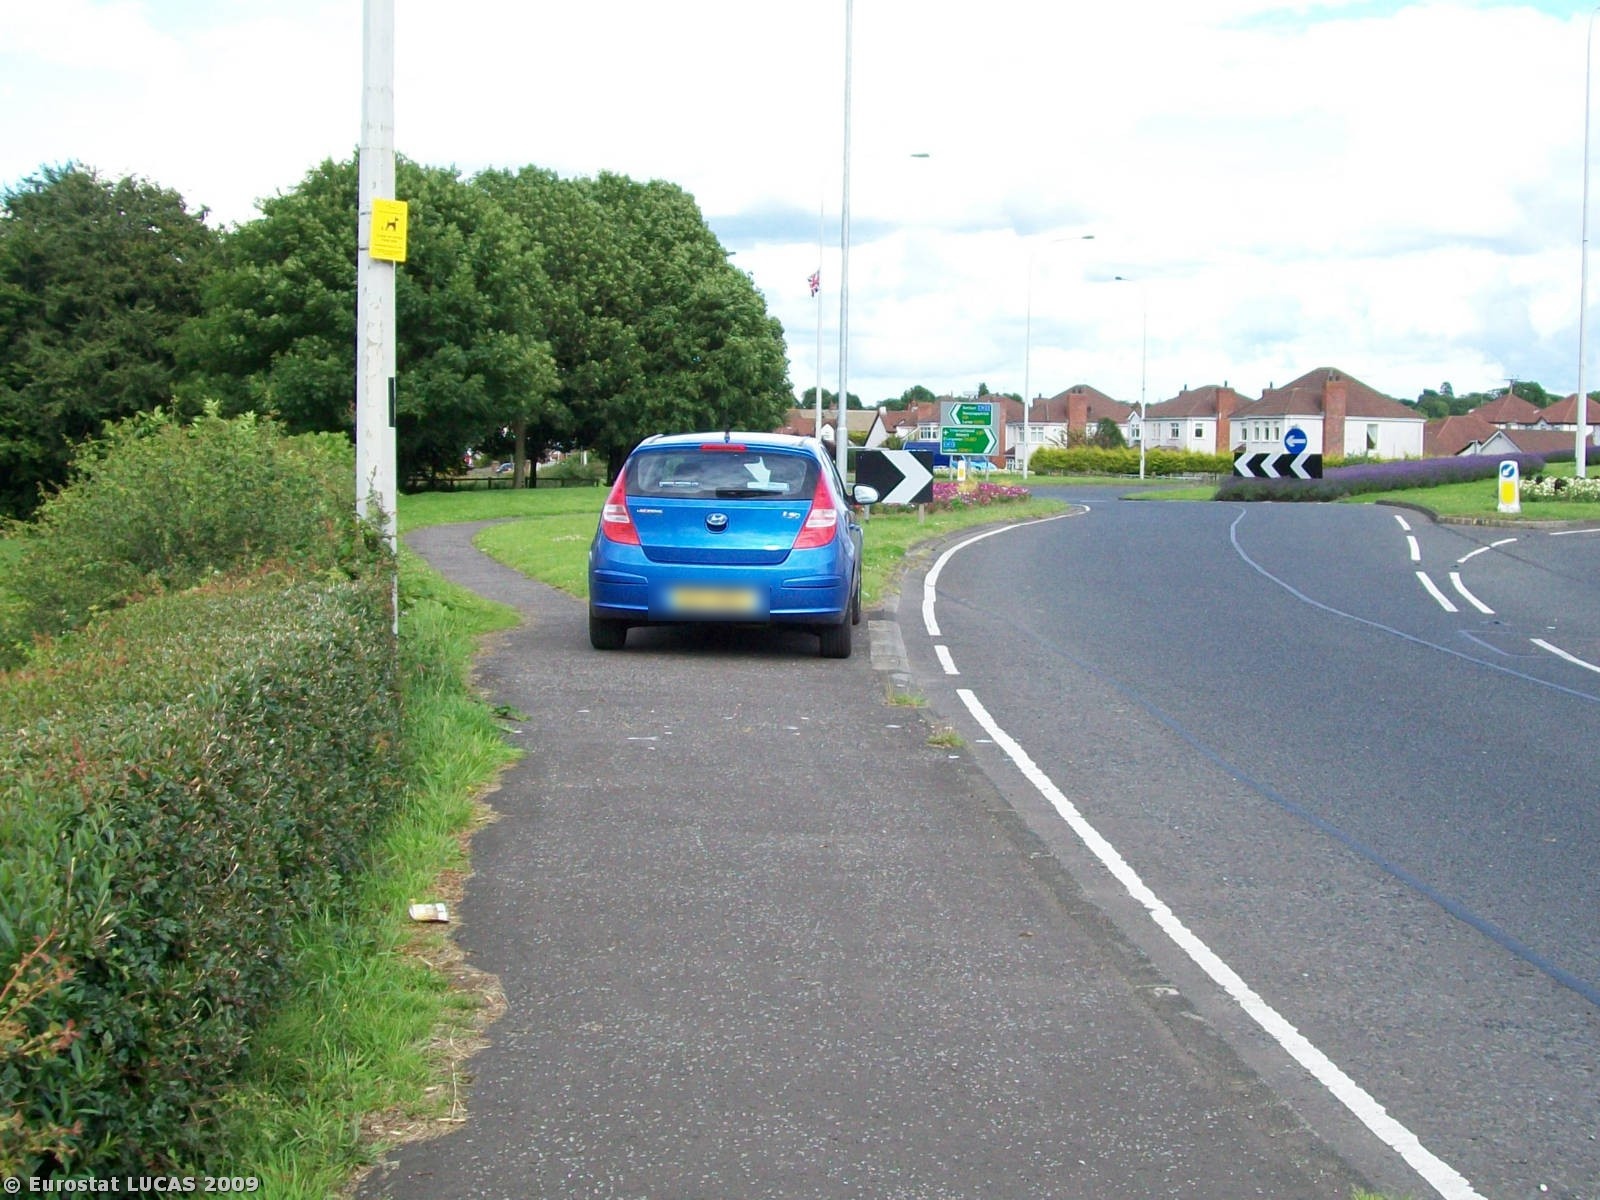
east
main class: Grassland
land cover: Grassland without tree/shrub cover
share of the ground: > 75 %
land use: Agriculture (excluding fallow land and kitchen gardens)
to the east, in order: Grassland without tree/shrub cover; Fences; Managed hedges; Grassland without tree/shrub cover; Fences; Abandoned hedges; Artificial constructions in urban areas; Paved roads, cycling and walking lanes; Artificial constructions in urban areas
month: July
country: GB
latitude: 54.7002
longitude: -6.1108
